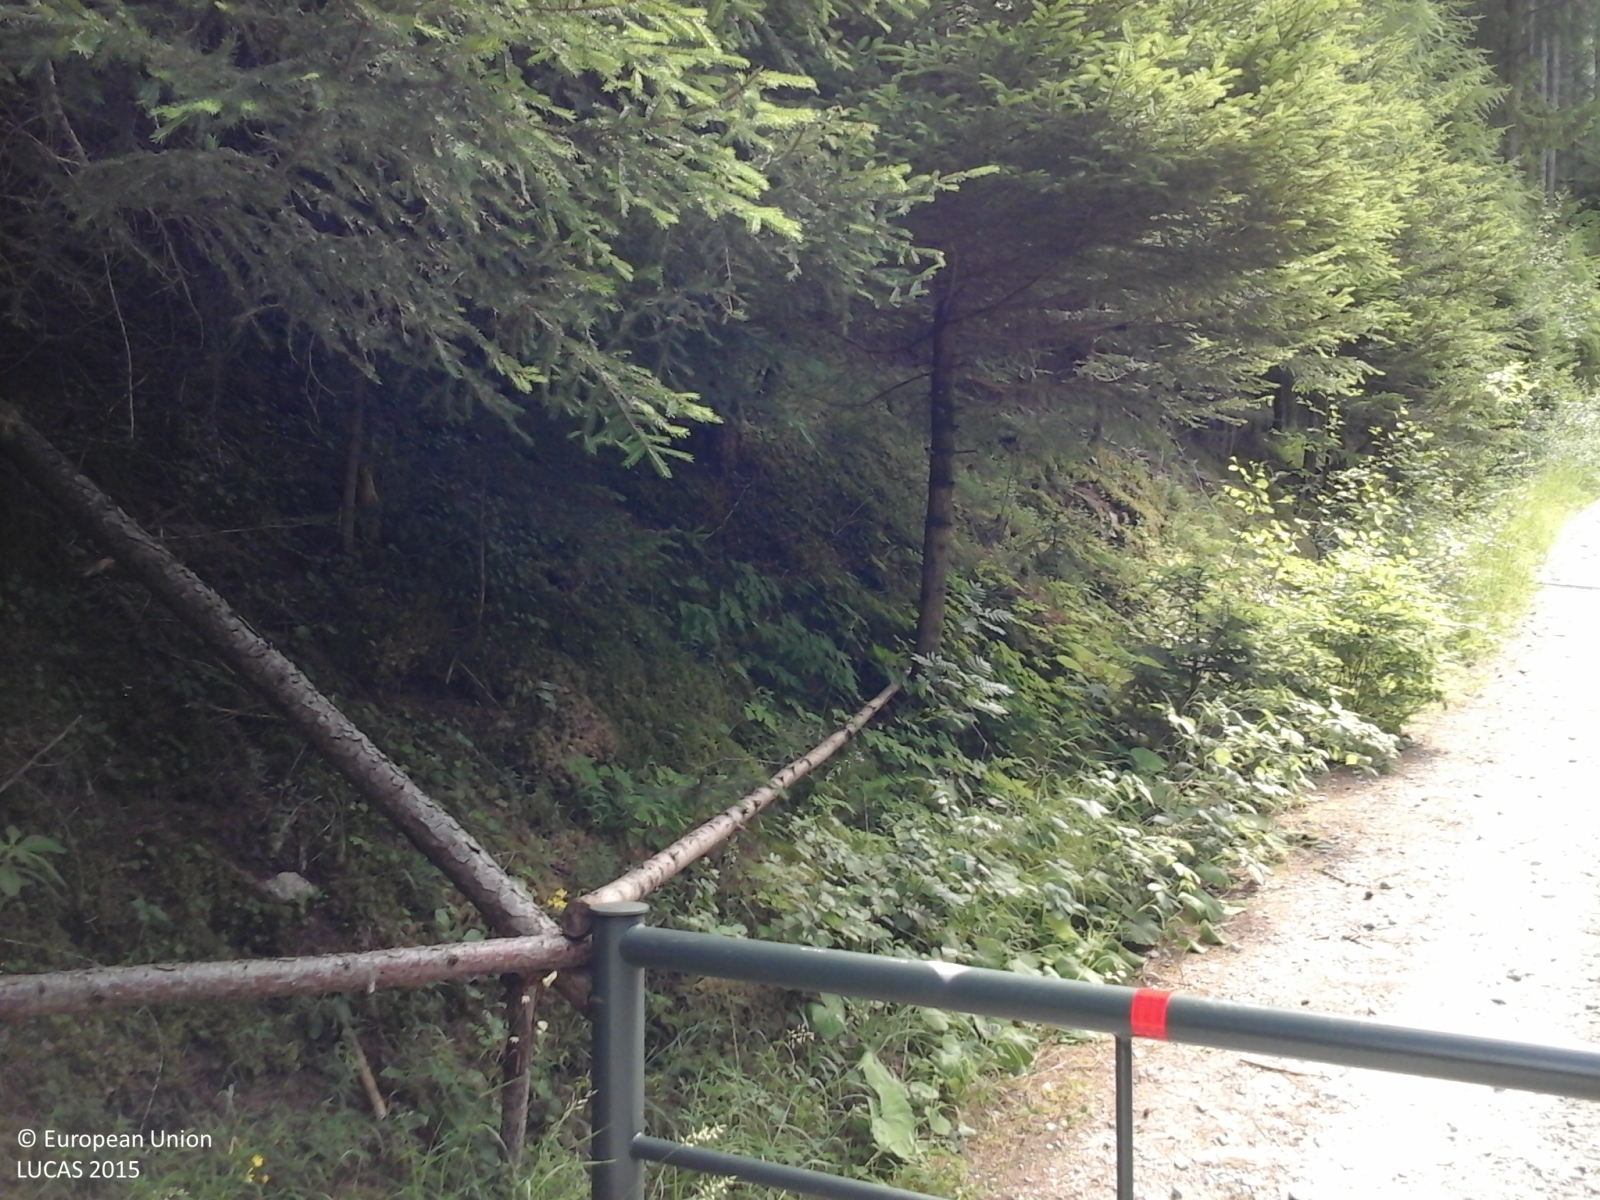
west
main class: Woodland
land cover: Spruce dominated coniferous woodland
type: alpine coniferous forest
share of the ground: > 75 %
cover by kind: coniferous forest trees 100 %
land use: Forestry
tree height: > 5 m
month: June
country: IT
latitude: 46.7718
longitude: 11.5829
